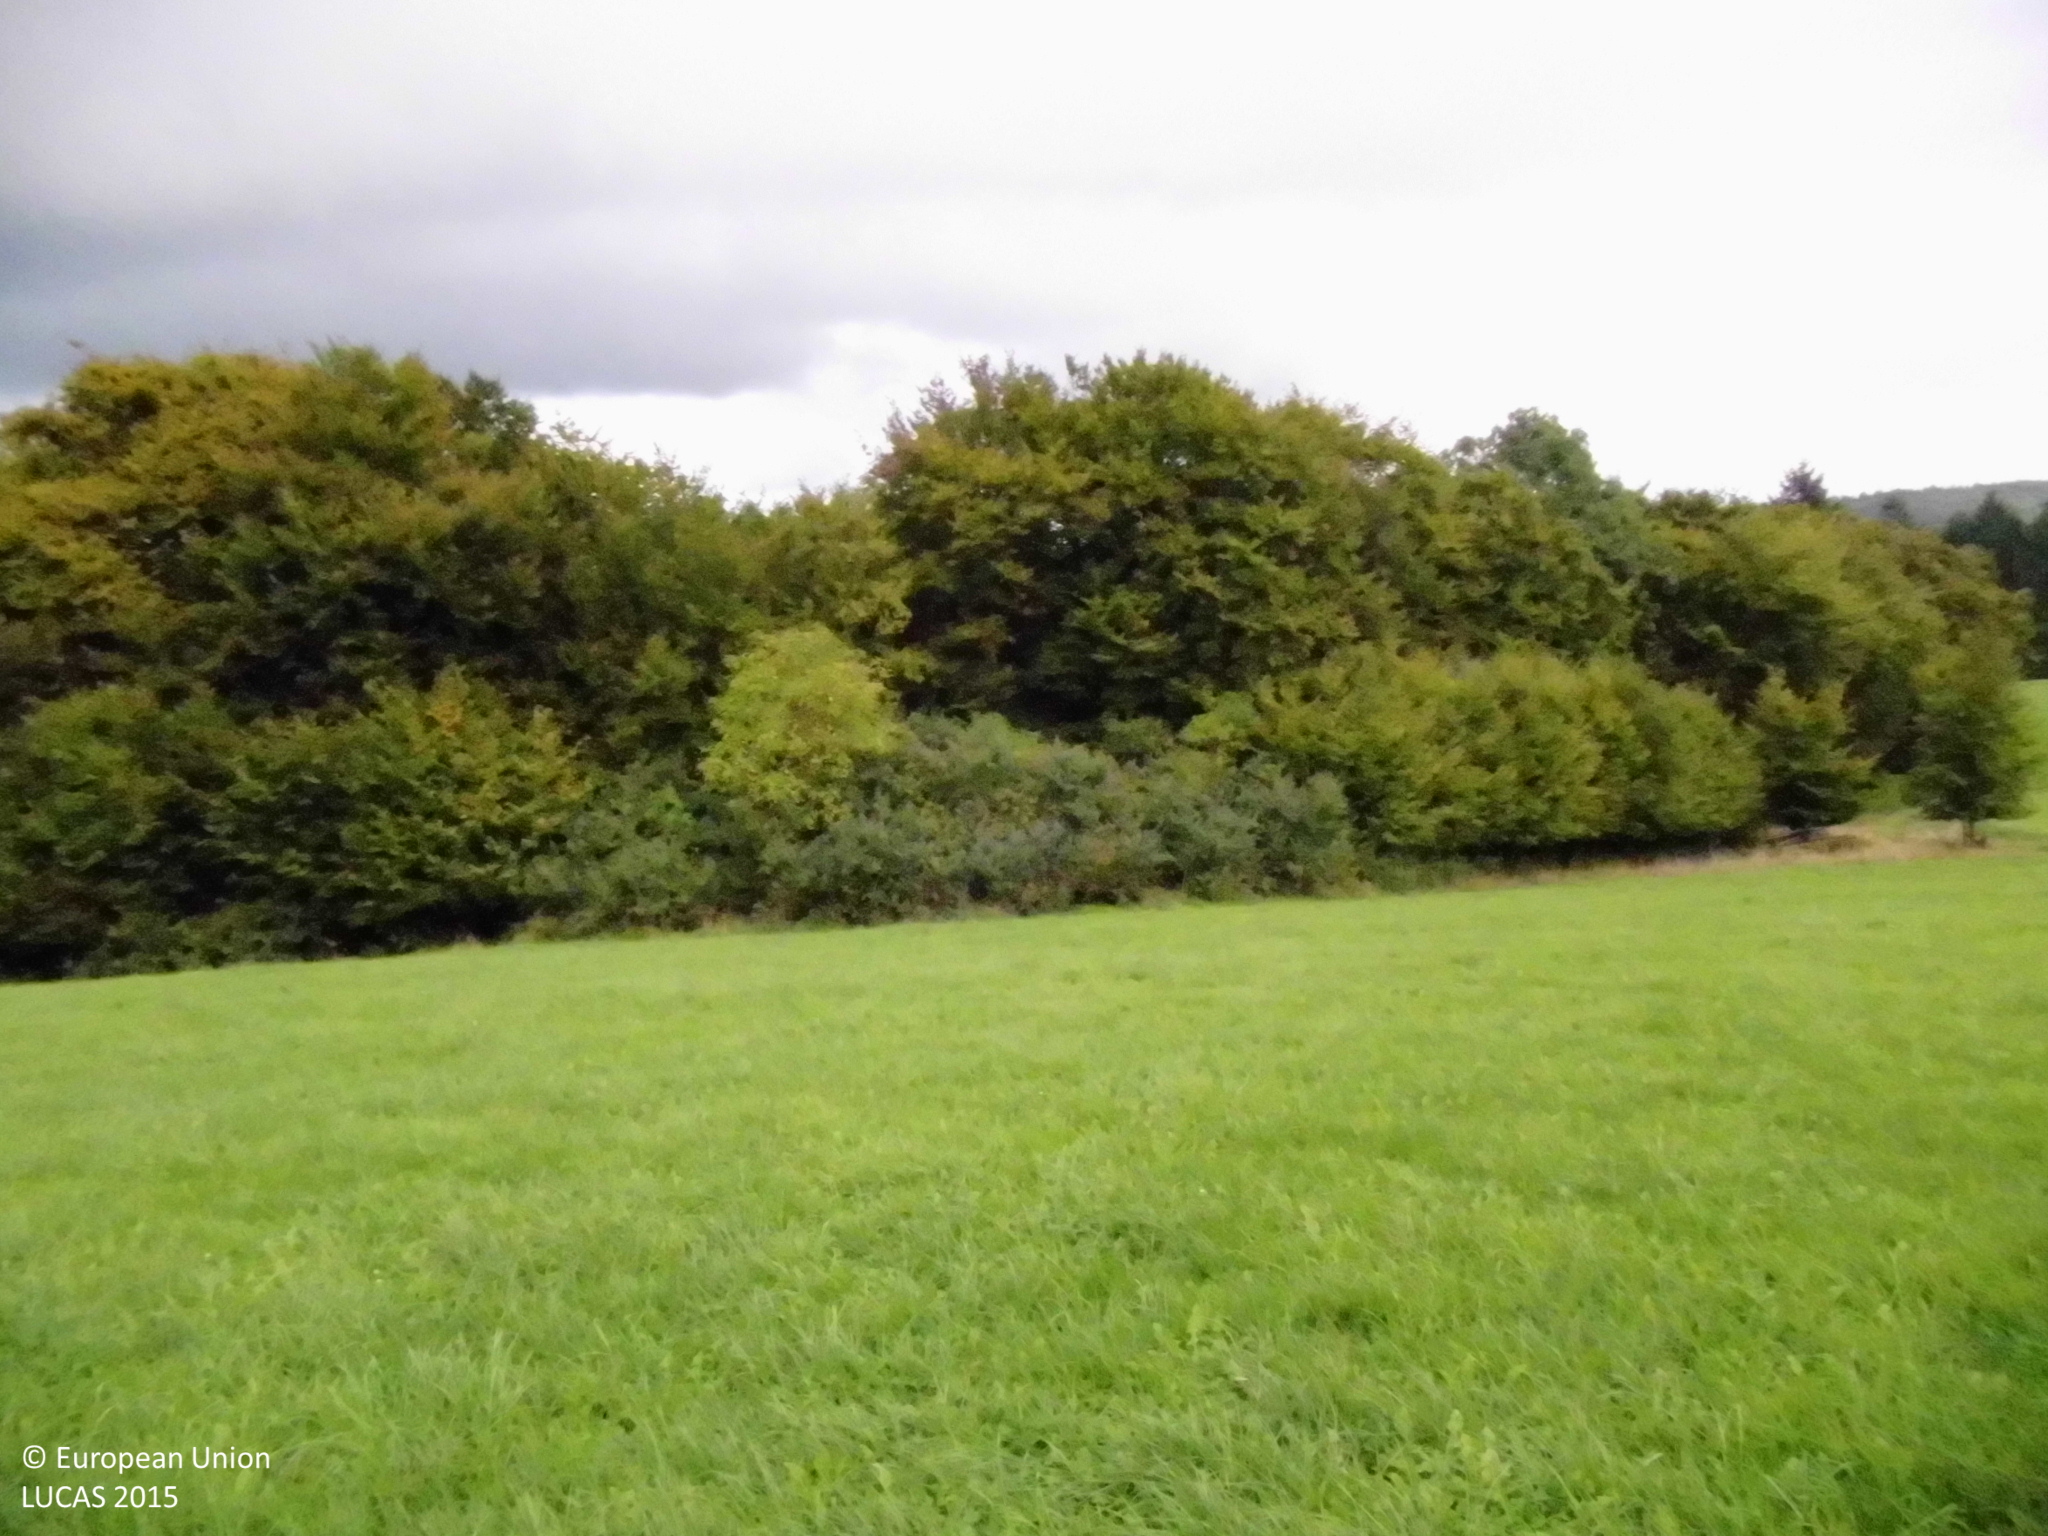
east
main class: Grassland
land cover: Grassland without tree/shrub cover
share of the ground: > 75 %
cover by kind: herbaceous plants 100 %
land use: Agriculture (excluding fallow land and kitchen gardens)
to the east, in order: Grassland without tree/shrub cover; Broadleaved woodland; Fences; Broadleaved woodland
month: September
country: DE
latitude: 50.5514
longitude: 7.4456
